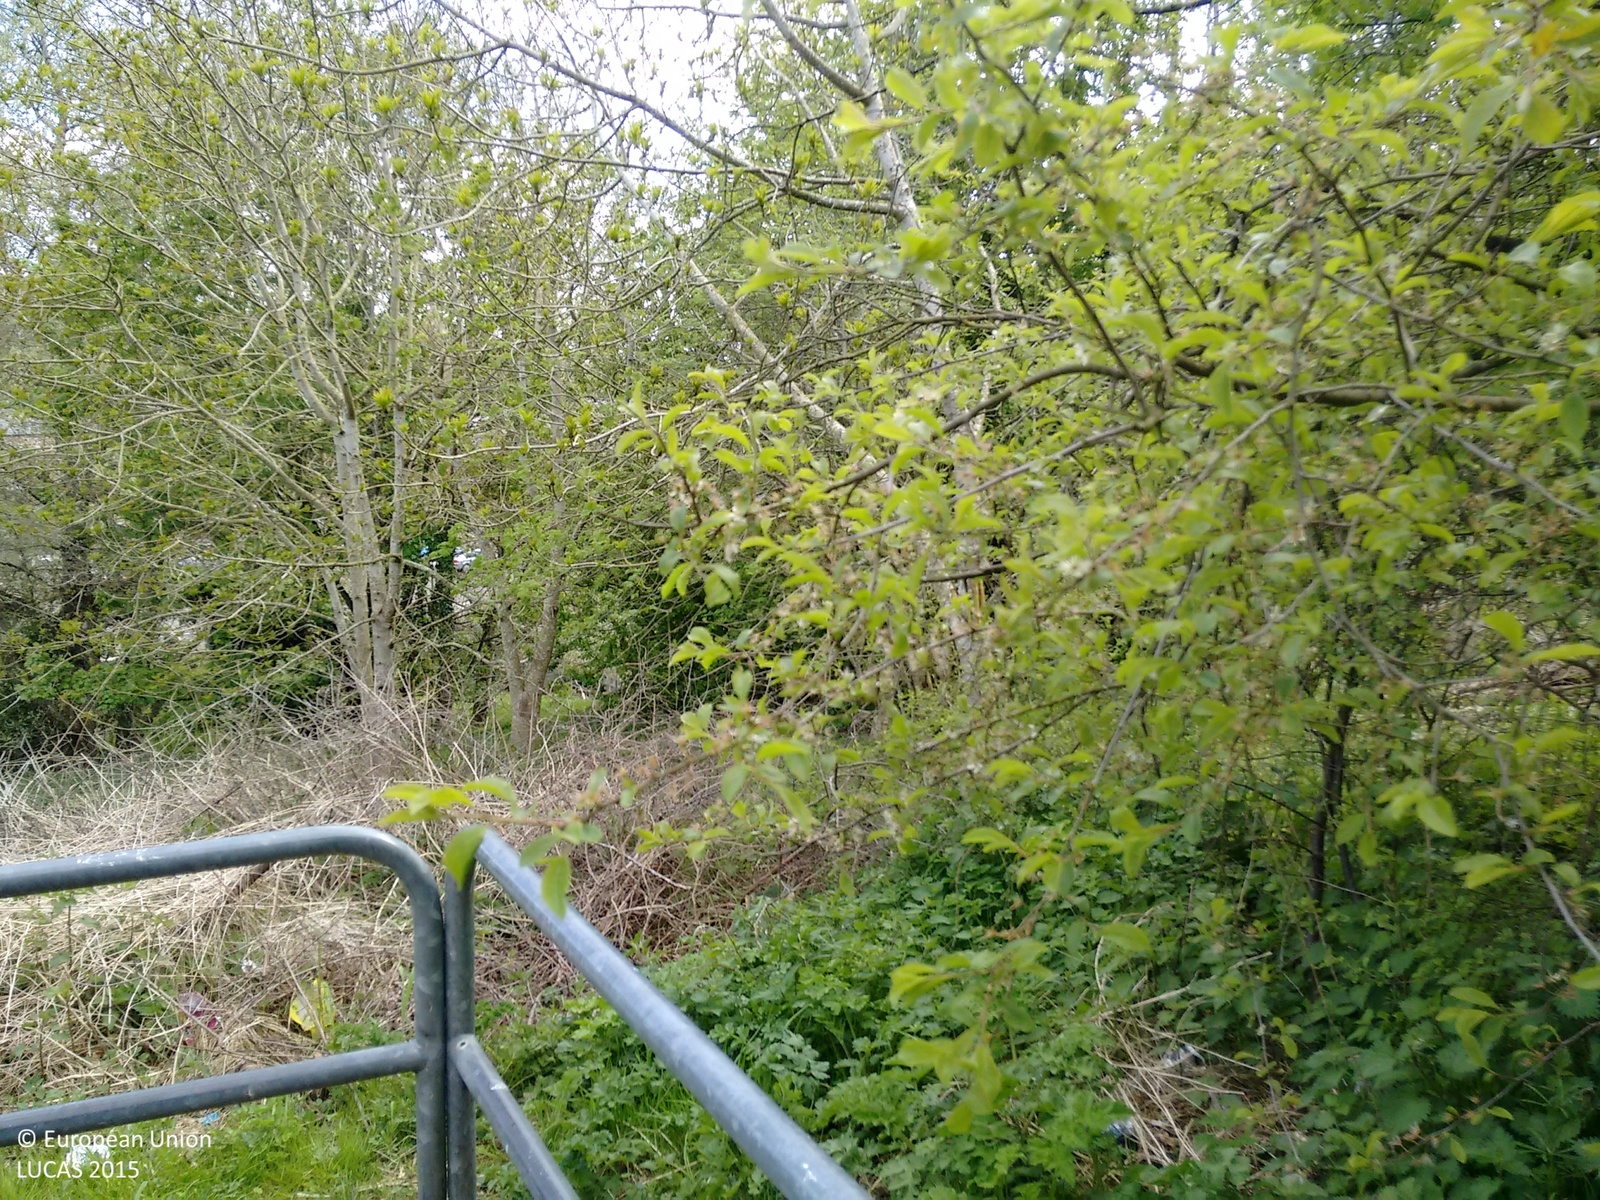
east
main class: Woodland
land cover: Broadleaved woodland
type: mesophytic deciduous forest
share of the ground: > 75 %
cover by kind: broadleaved forest trees 75 %, herbaceous plants 25 %
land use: Amenities, museums, leisure
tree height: > 5 m
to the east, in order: Broadleaved woodland; Artificial constructions in urban areas; Rivers and streams; Lines of trees; Grassland without tree/shrub cover; Artificial constructions in urban areas; Rivers and streams; Broadleaved woodland; Tracks; Grassland without tree/shrub cover; Tracks; Lines of trees; Grassland without tree/shrub cover
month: May
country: GB
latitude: 56.6714
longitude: -3.0062
